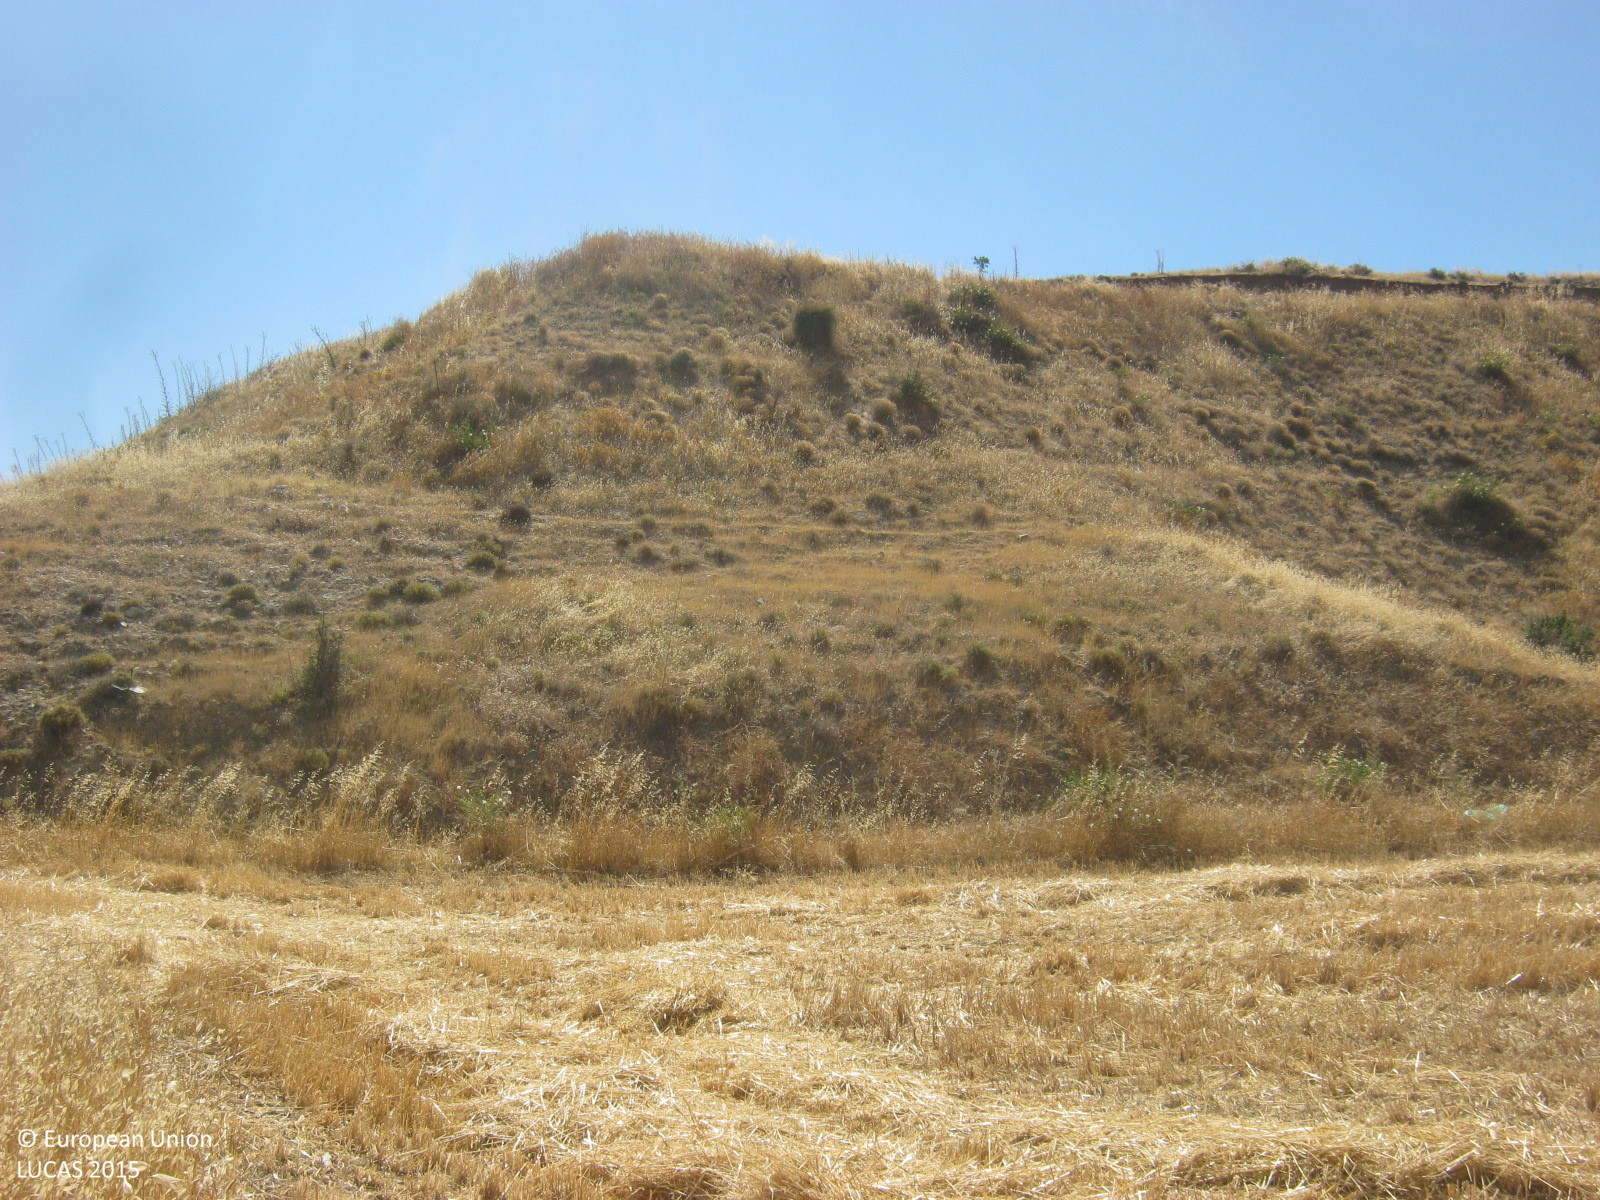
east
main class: Grassland
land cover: Spontaneously vegetated surfaces
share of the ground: > 75 %
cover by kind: herbaceous plants 85 %, unconsolidated bare surface 10 %, shrubs 5 %
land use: Semi-natural and natural areas not in use
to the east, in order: Spontaneously vegetated surfaces; Other bare soil; Spontaneously vegetated surfaces; Other bare soil; Grassland with sparse tree/shrub cover; Tracks; Grassland with sparse tree/shrub cover; Other bare soil; Electric lines; Paved roads, cycling and walking lanes; Grass margins; Other bare soil
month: June
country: CY
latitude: 35.0498
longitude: 33.1726
